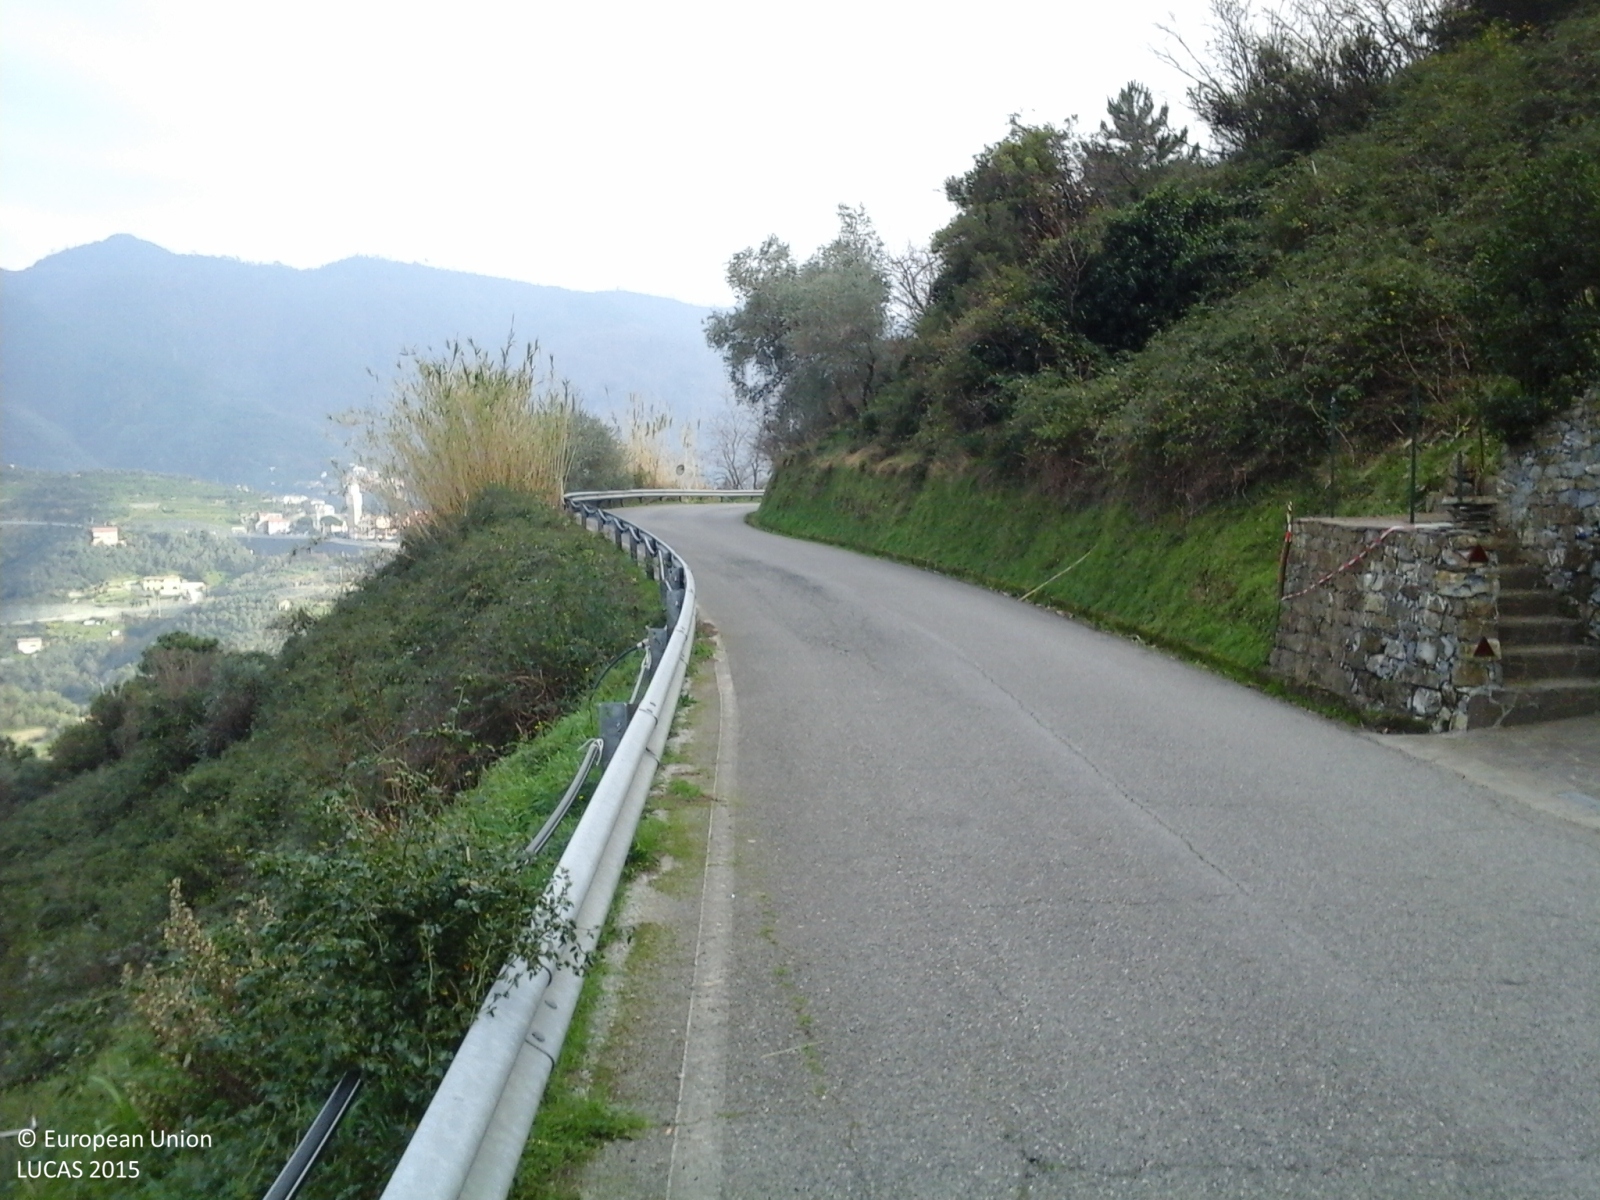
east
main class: Woodland
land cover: Broadleaved woodland
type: thermophilous deciduous forest
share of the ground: > 75 %
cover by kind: broadleaved forest trees 75 %, coniferous forest trees 10 %, shrubs 10 %, herbaceous plants 5 %
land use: Forestry
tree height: > 5 m
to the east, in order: Broadleaved woodland; Paved roads, cycling and walking lanes; Single bushes/trees; Grass margins; Paved roads, cycling and walking lanes; Shrubland with sparse tree cover; Olive groves; Grassland with sparse tree/shrub cover; Shrubland with sparse tree cover
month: October
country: IT
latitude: 44.1875
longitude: 9.6131
